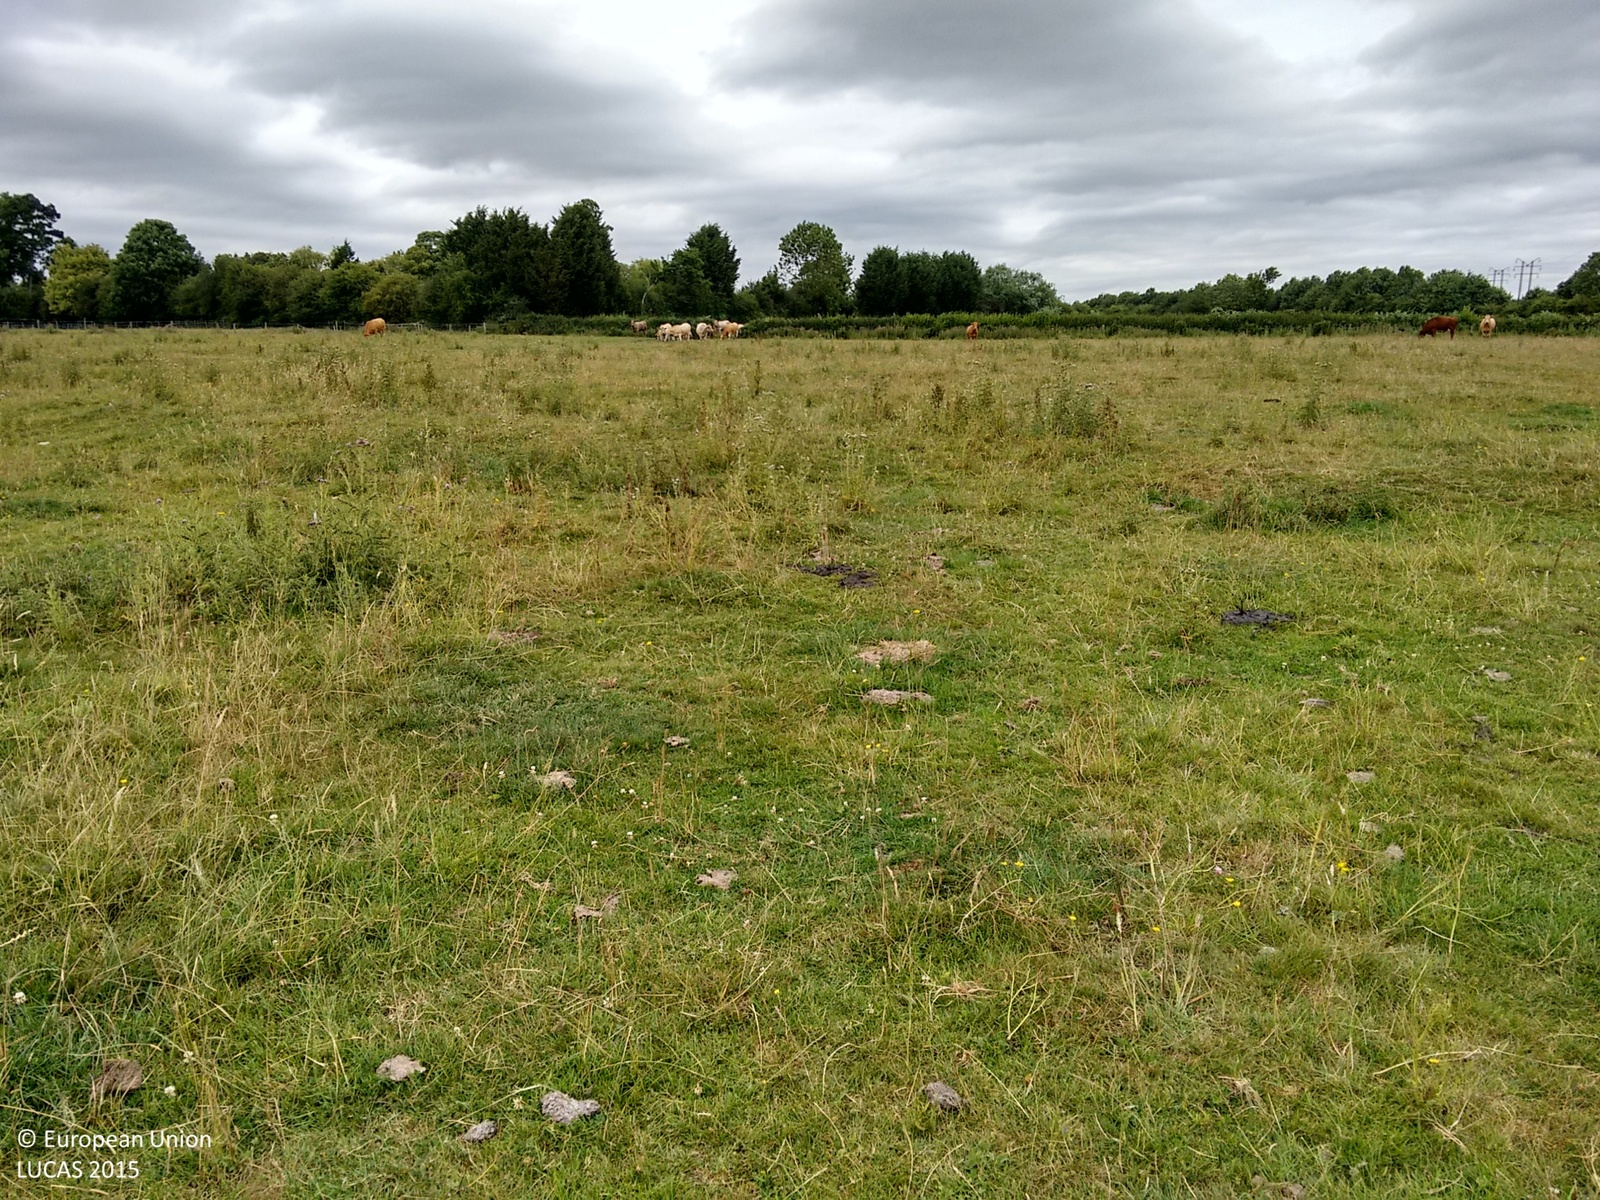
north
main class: Grassland
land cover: Grassland without tree/shrub cover
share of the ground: > 75 %
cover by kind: herbaceous plants 100 %
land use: Agriculture (excluding fallow land and kitchen gardens)
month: July
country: GB
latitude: 52.4912
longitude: -0.8973
